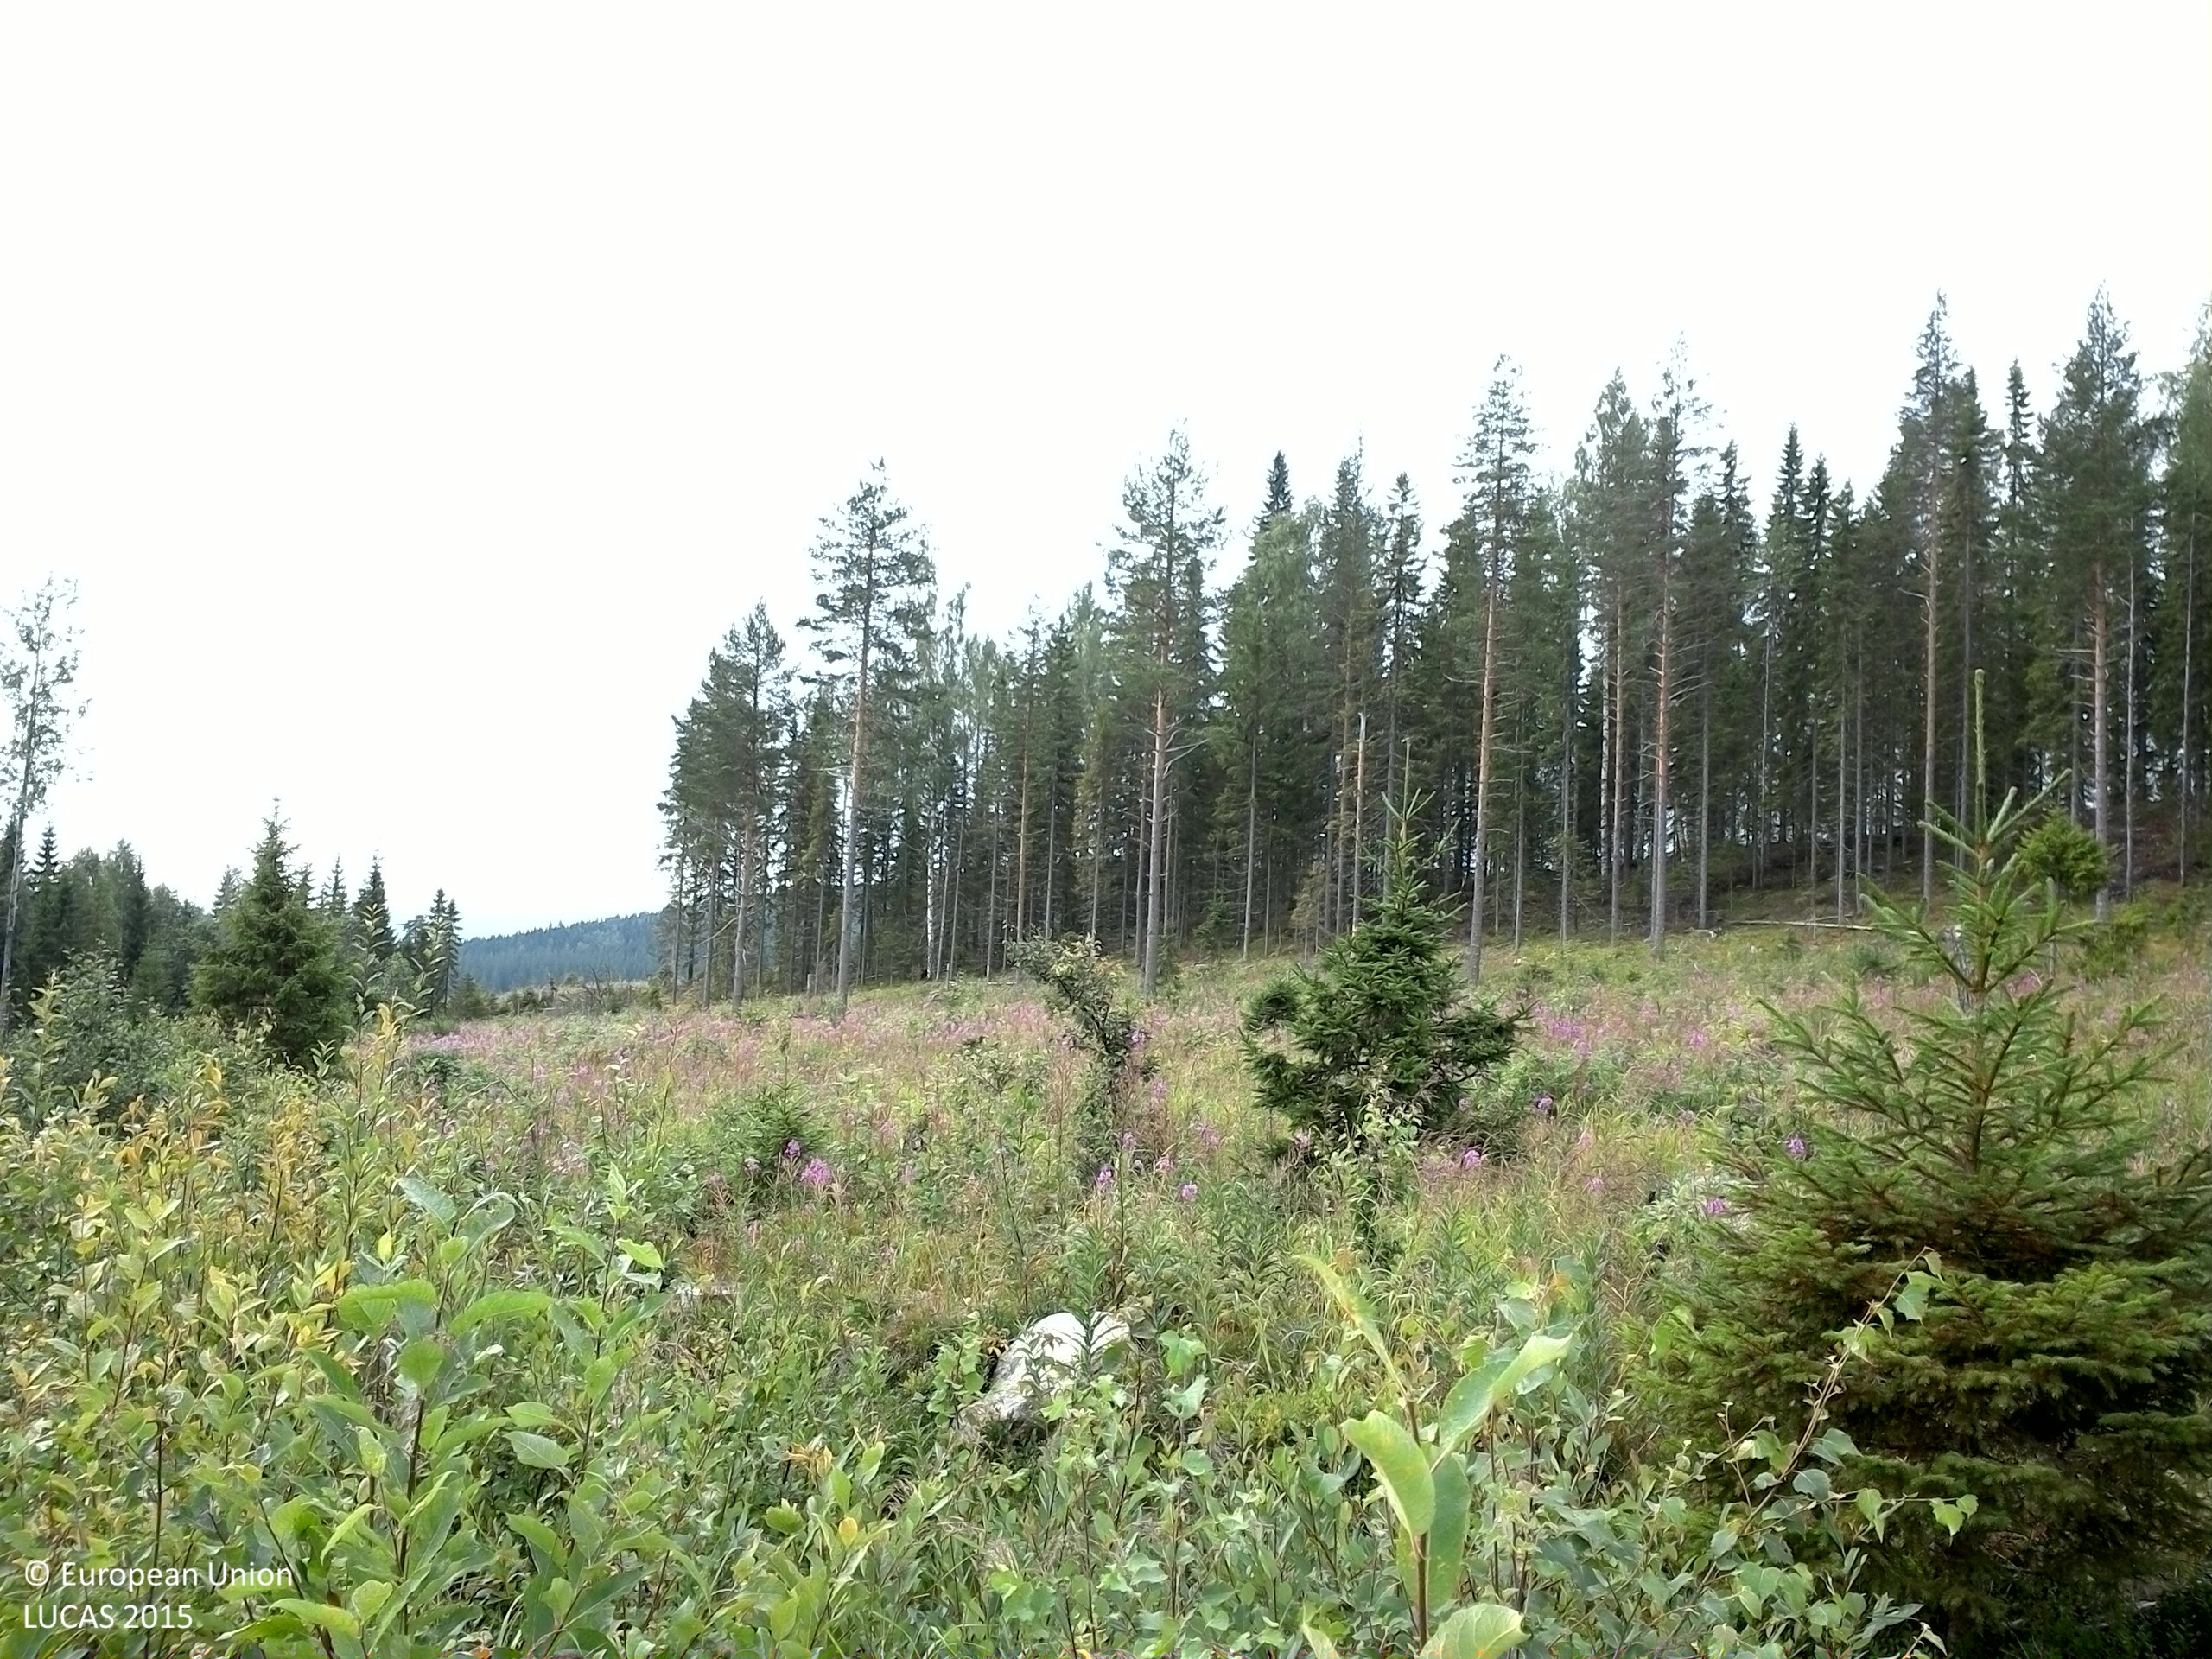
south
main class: Artificial land
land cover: Non built-up linear features
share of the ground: > 75 %
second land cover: Spontaneously vegetated surfaces
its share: 25 - 50 %
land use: Road transport
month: August
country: SE
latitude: 63.5879
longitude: 18.1754
